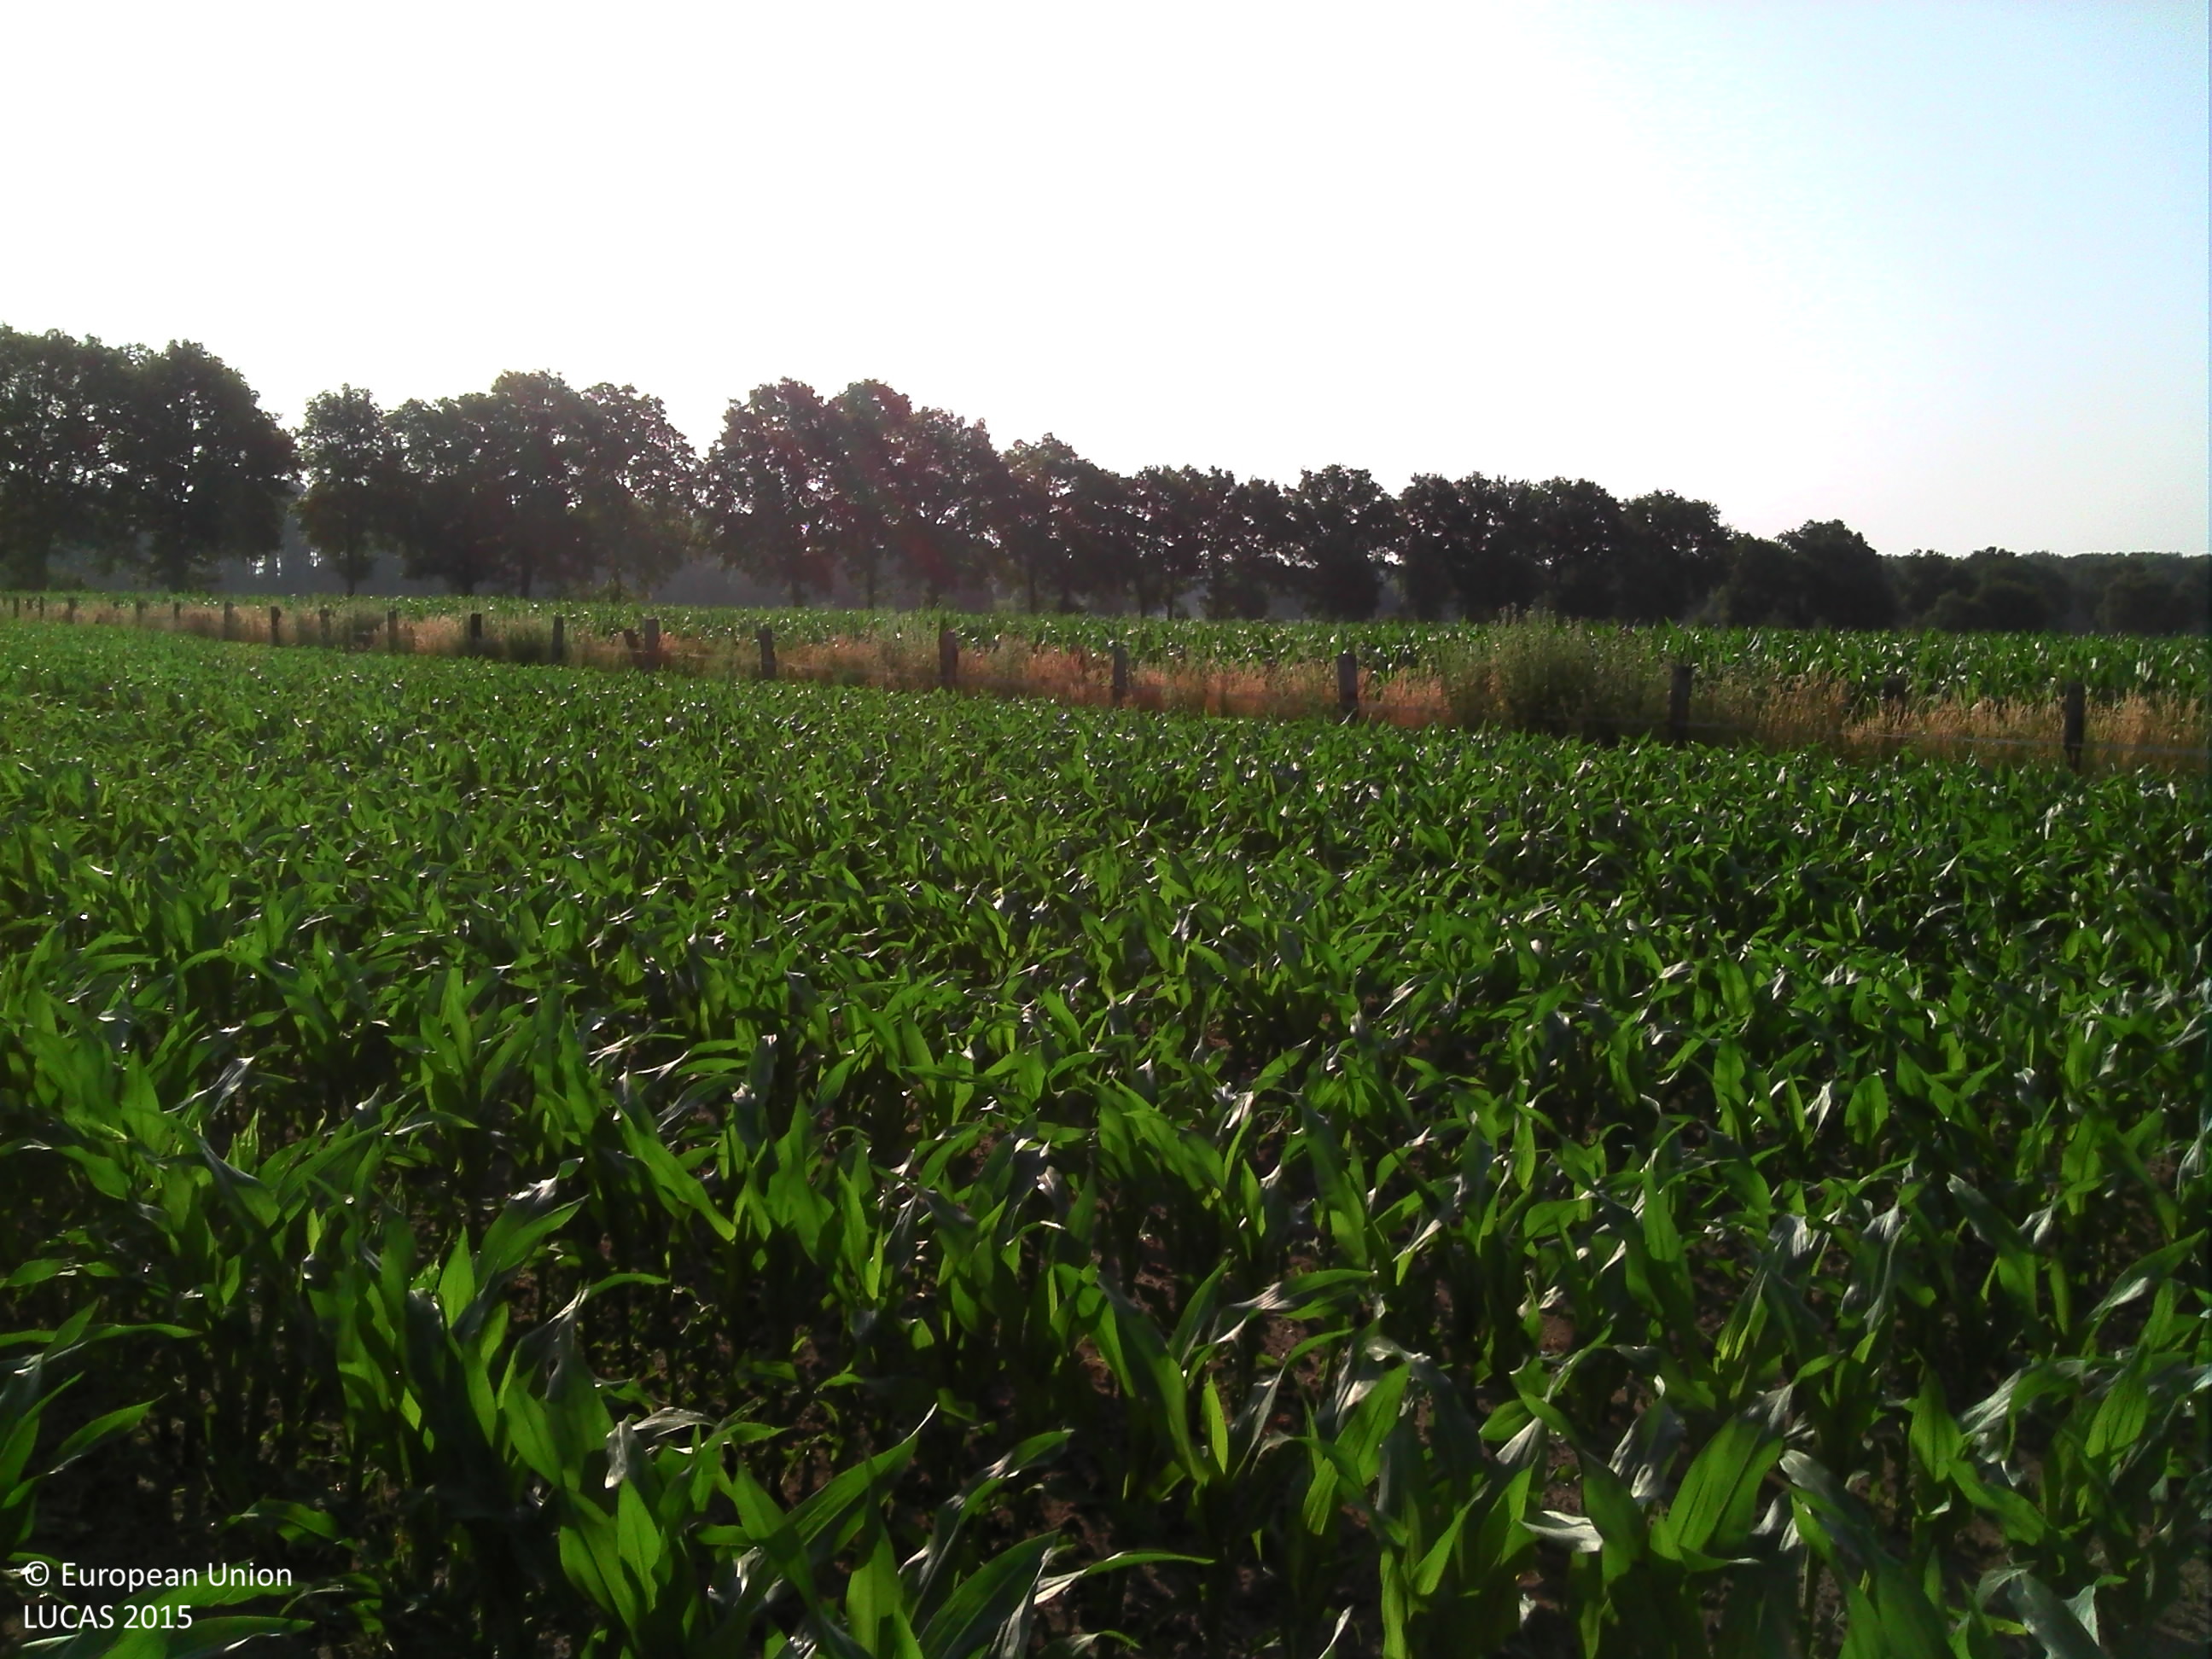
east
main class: Cropland
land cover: Maize
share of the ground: 50 - 75 %
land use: Agriculture (excluding fallow land and kitchen gardens)
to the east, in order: Maize; Fences; Grass margins; Fences; Maize; Fences; Ditches and canals; Grass margins; Tracks; Grass margins; Lines of trees; Grass margins; Maize
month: July
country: BE
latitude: 51.0702
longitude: 5.5599
